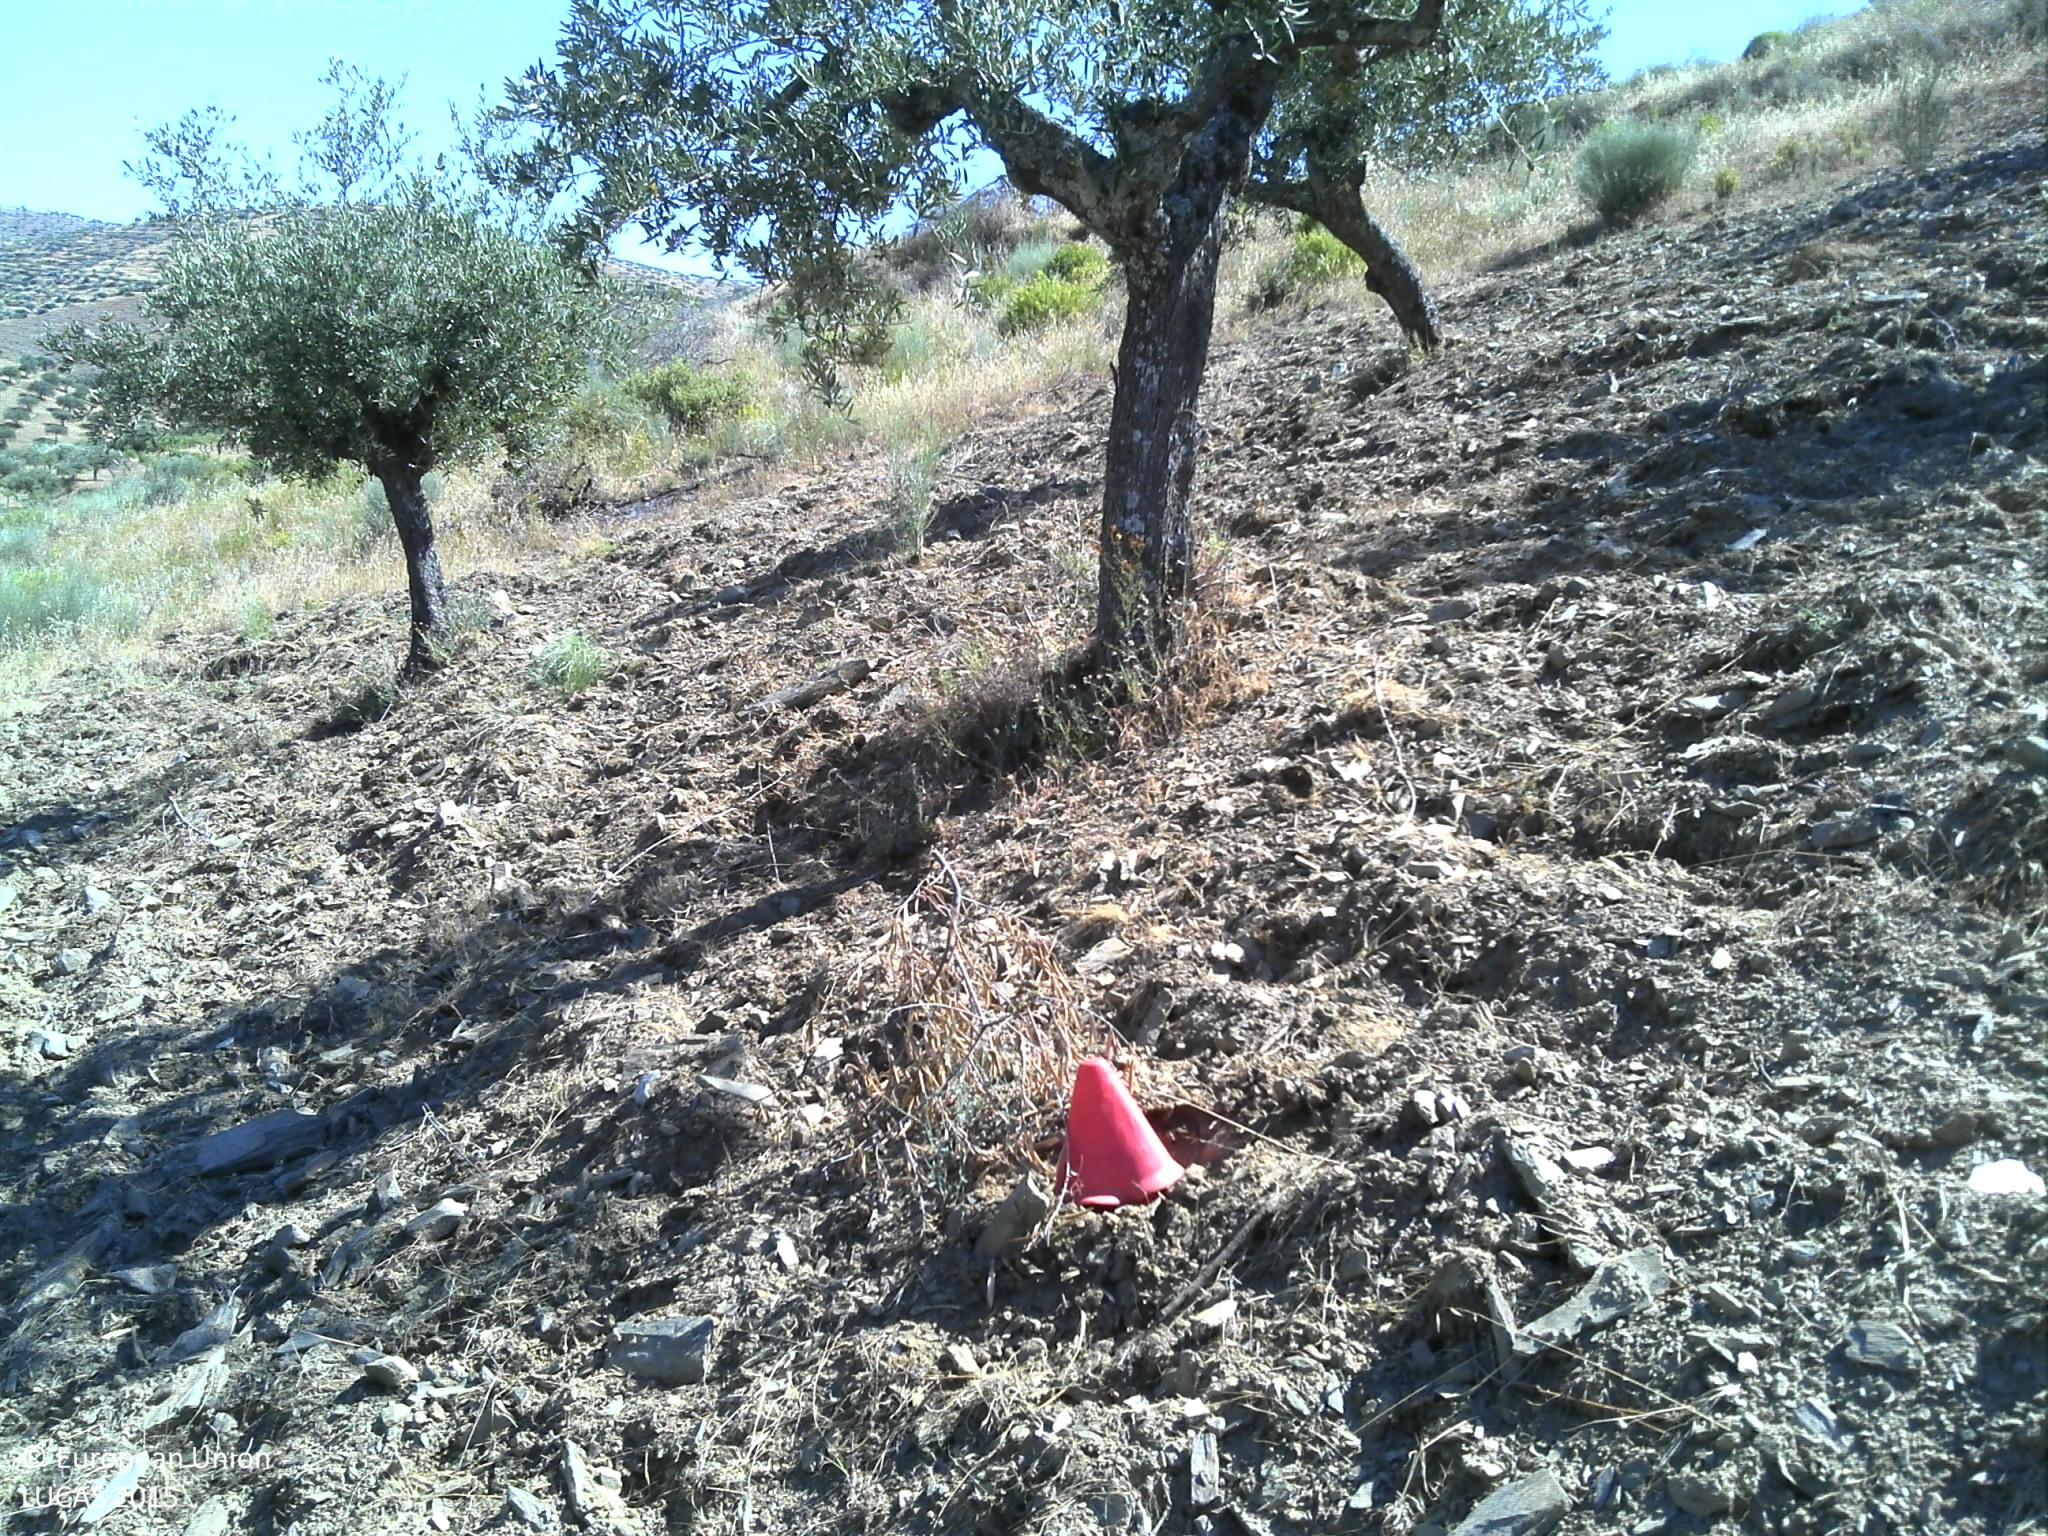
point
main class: Cropland
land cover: Olive groves
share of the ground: < 10 %
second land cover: Other bare soil
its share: > 75 %
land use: Agriculture (excluding fallow land and kitchen gardens)
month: June
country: PT
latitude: 41.0057
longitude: -6.9776
